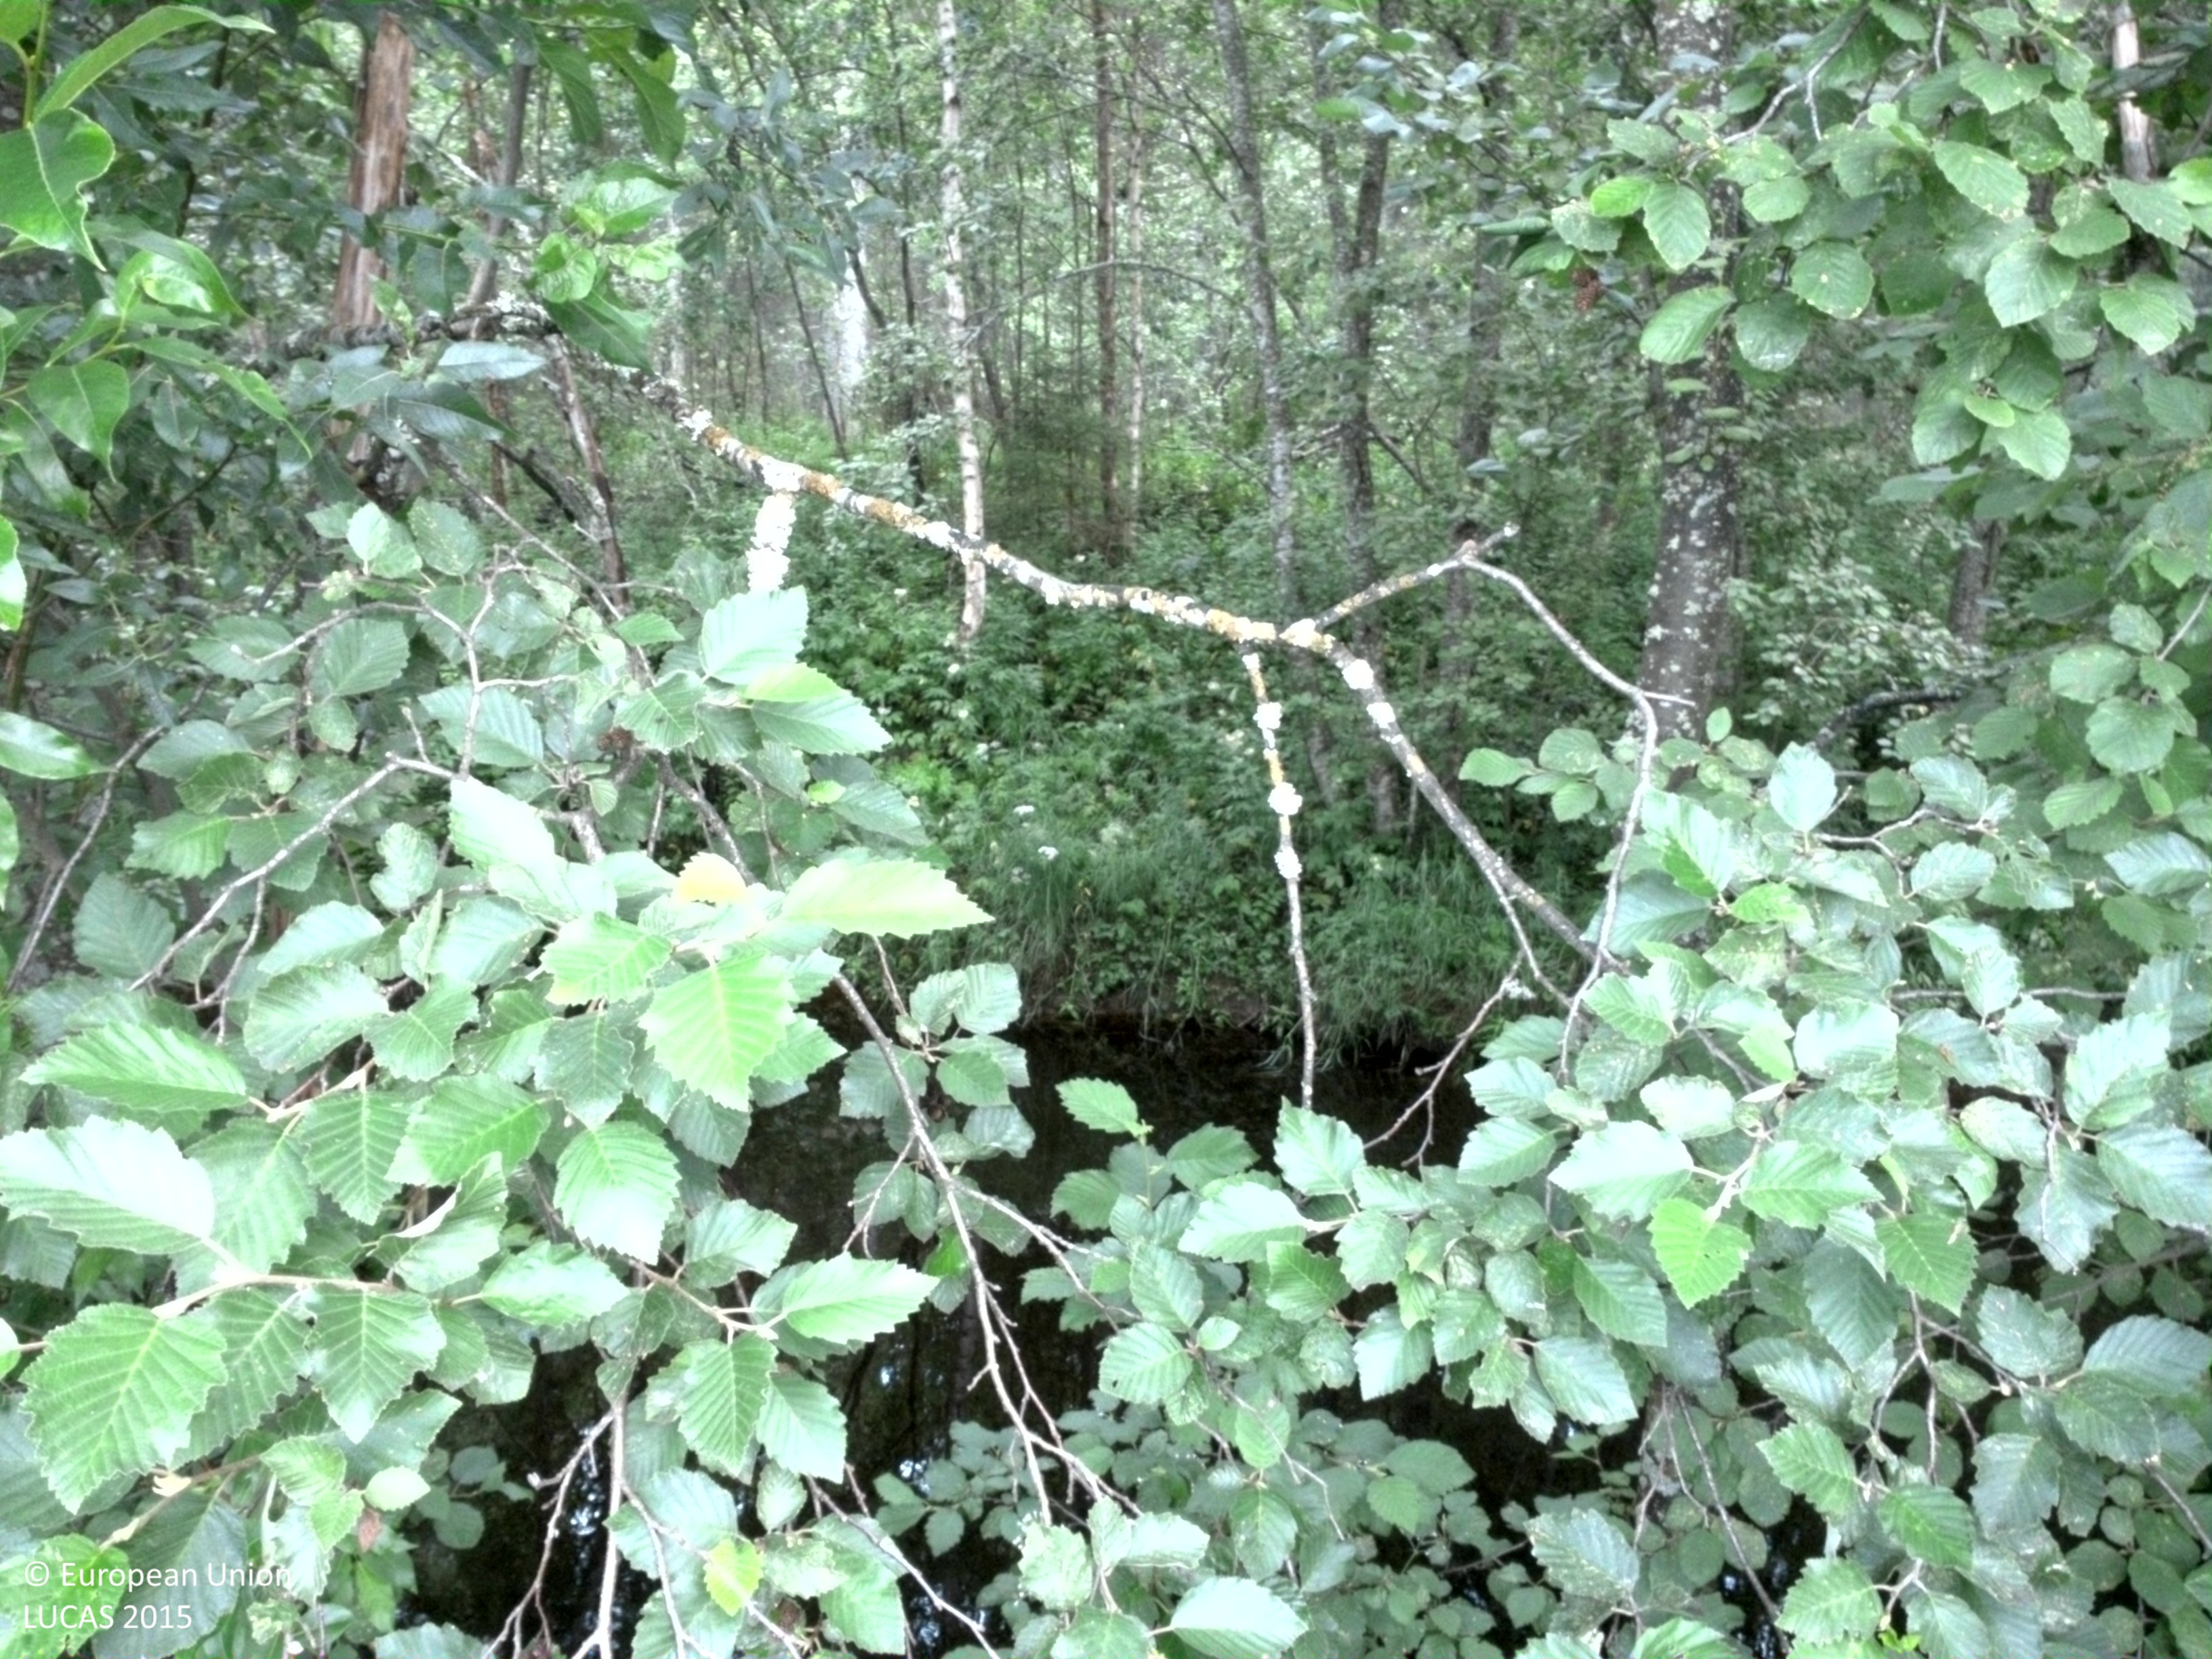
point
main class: Woodland
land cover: Broadleaved woodland
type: boreal forest
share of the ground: > 75 %
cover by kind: broadleaved forest trees 70 %, herbaceous plants 15 %, coniferous forest trees 10 %, shrubs 5 %
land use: Semi-natural and natural areas not in use
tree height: > 5 m
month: August
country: SE
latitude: 64.6964
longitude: 20.6495
